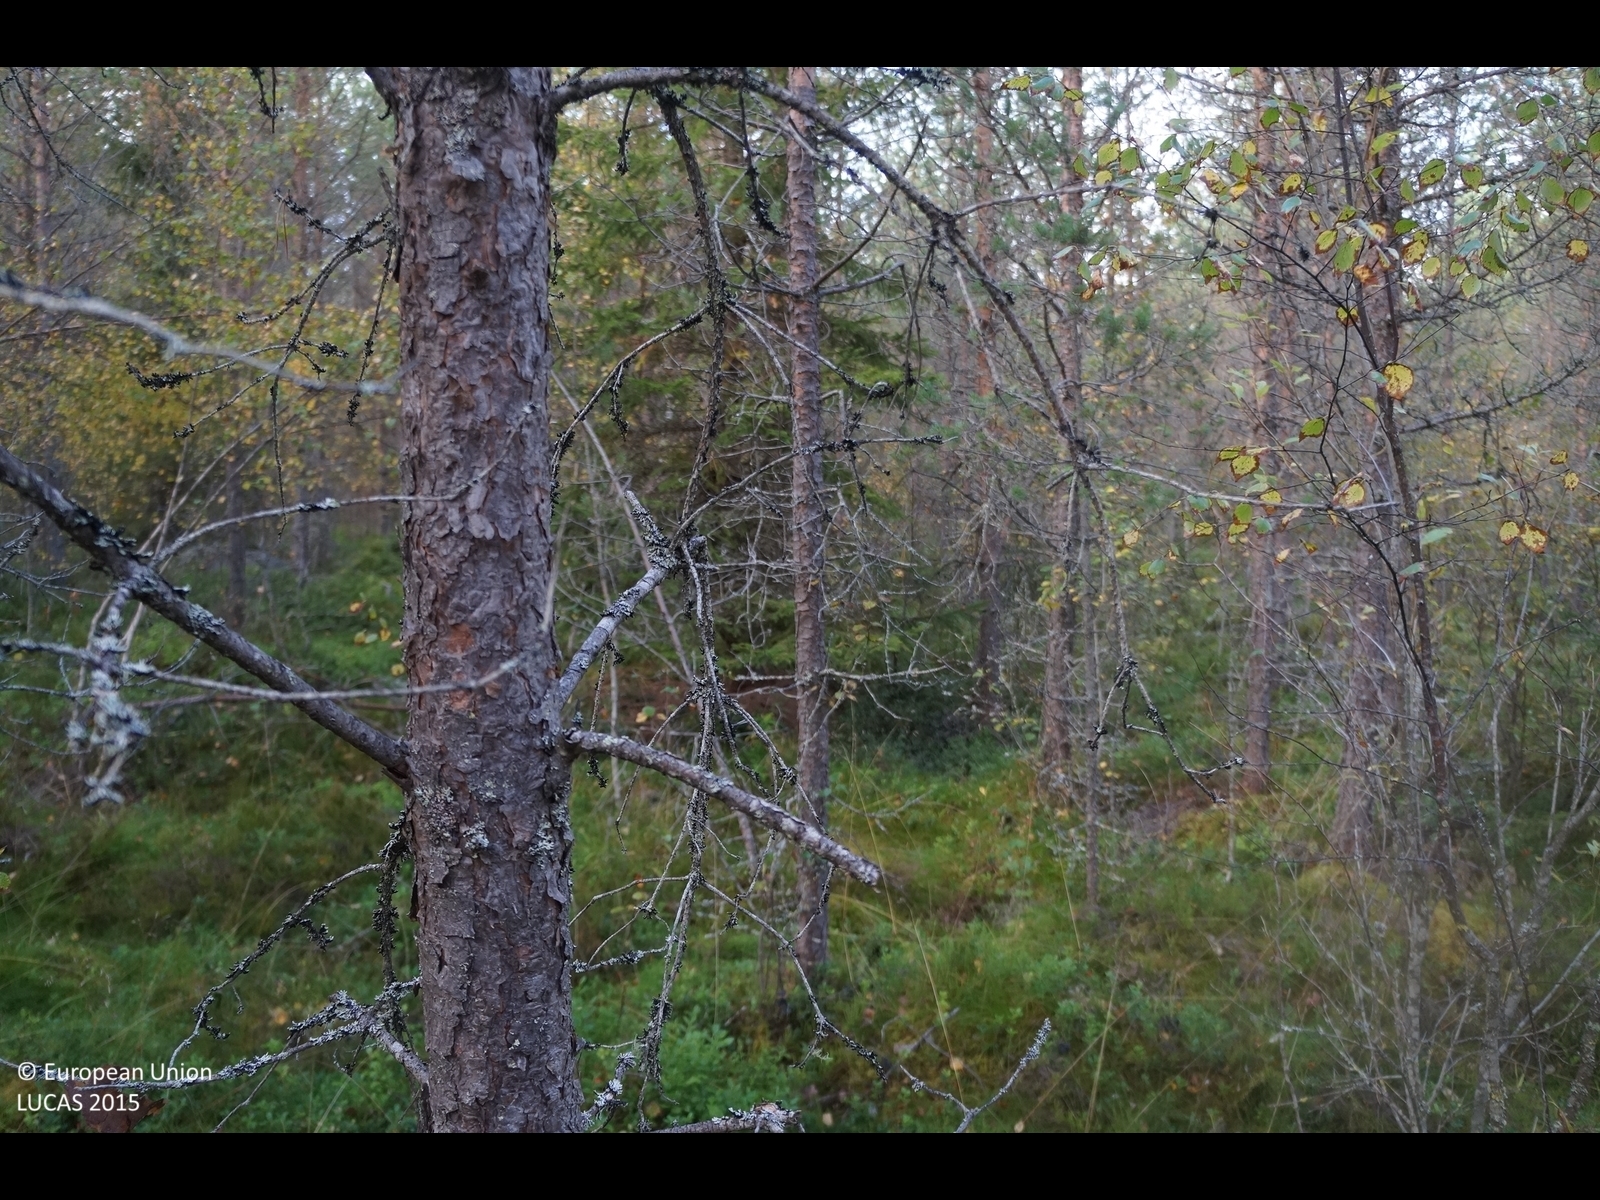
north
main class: Woodland
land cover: Pine dominated coniferous woodland
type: boreal forest
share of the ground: 50 - 75 %
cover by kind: coniferous forest trees 70 %, shrubs 20 %, herbaceous plants 5 %, lichens and mosses 5 %
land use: Forestry
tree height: > 5 m
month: September
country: FI
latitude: 63.8786
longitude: 24.2606
